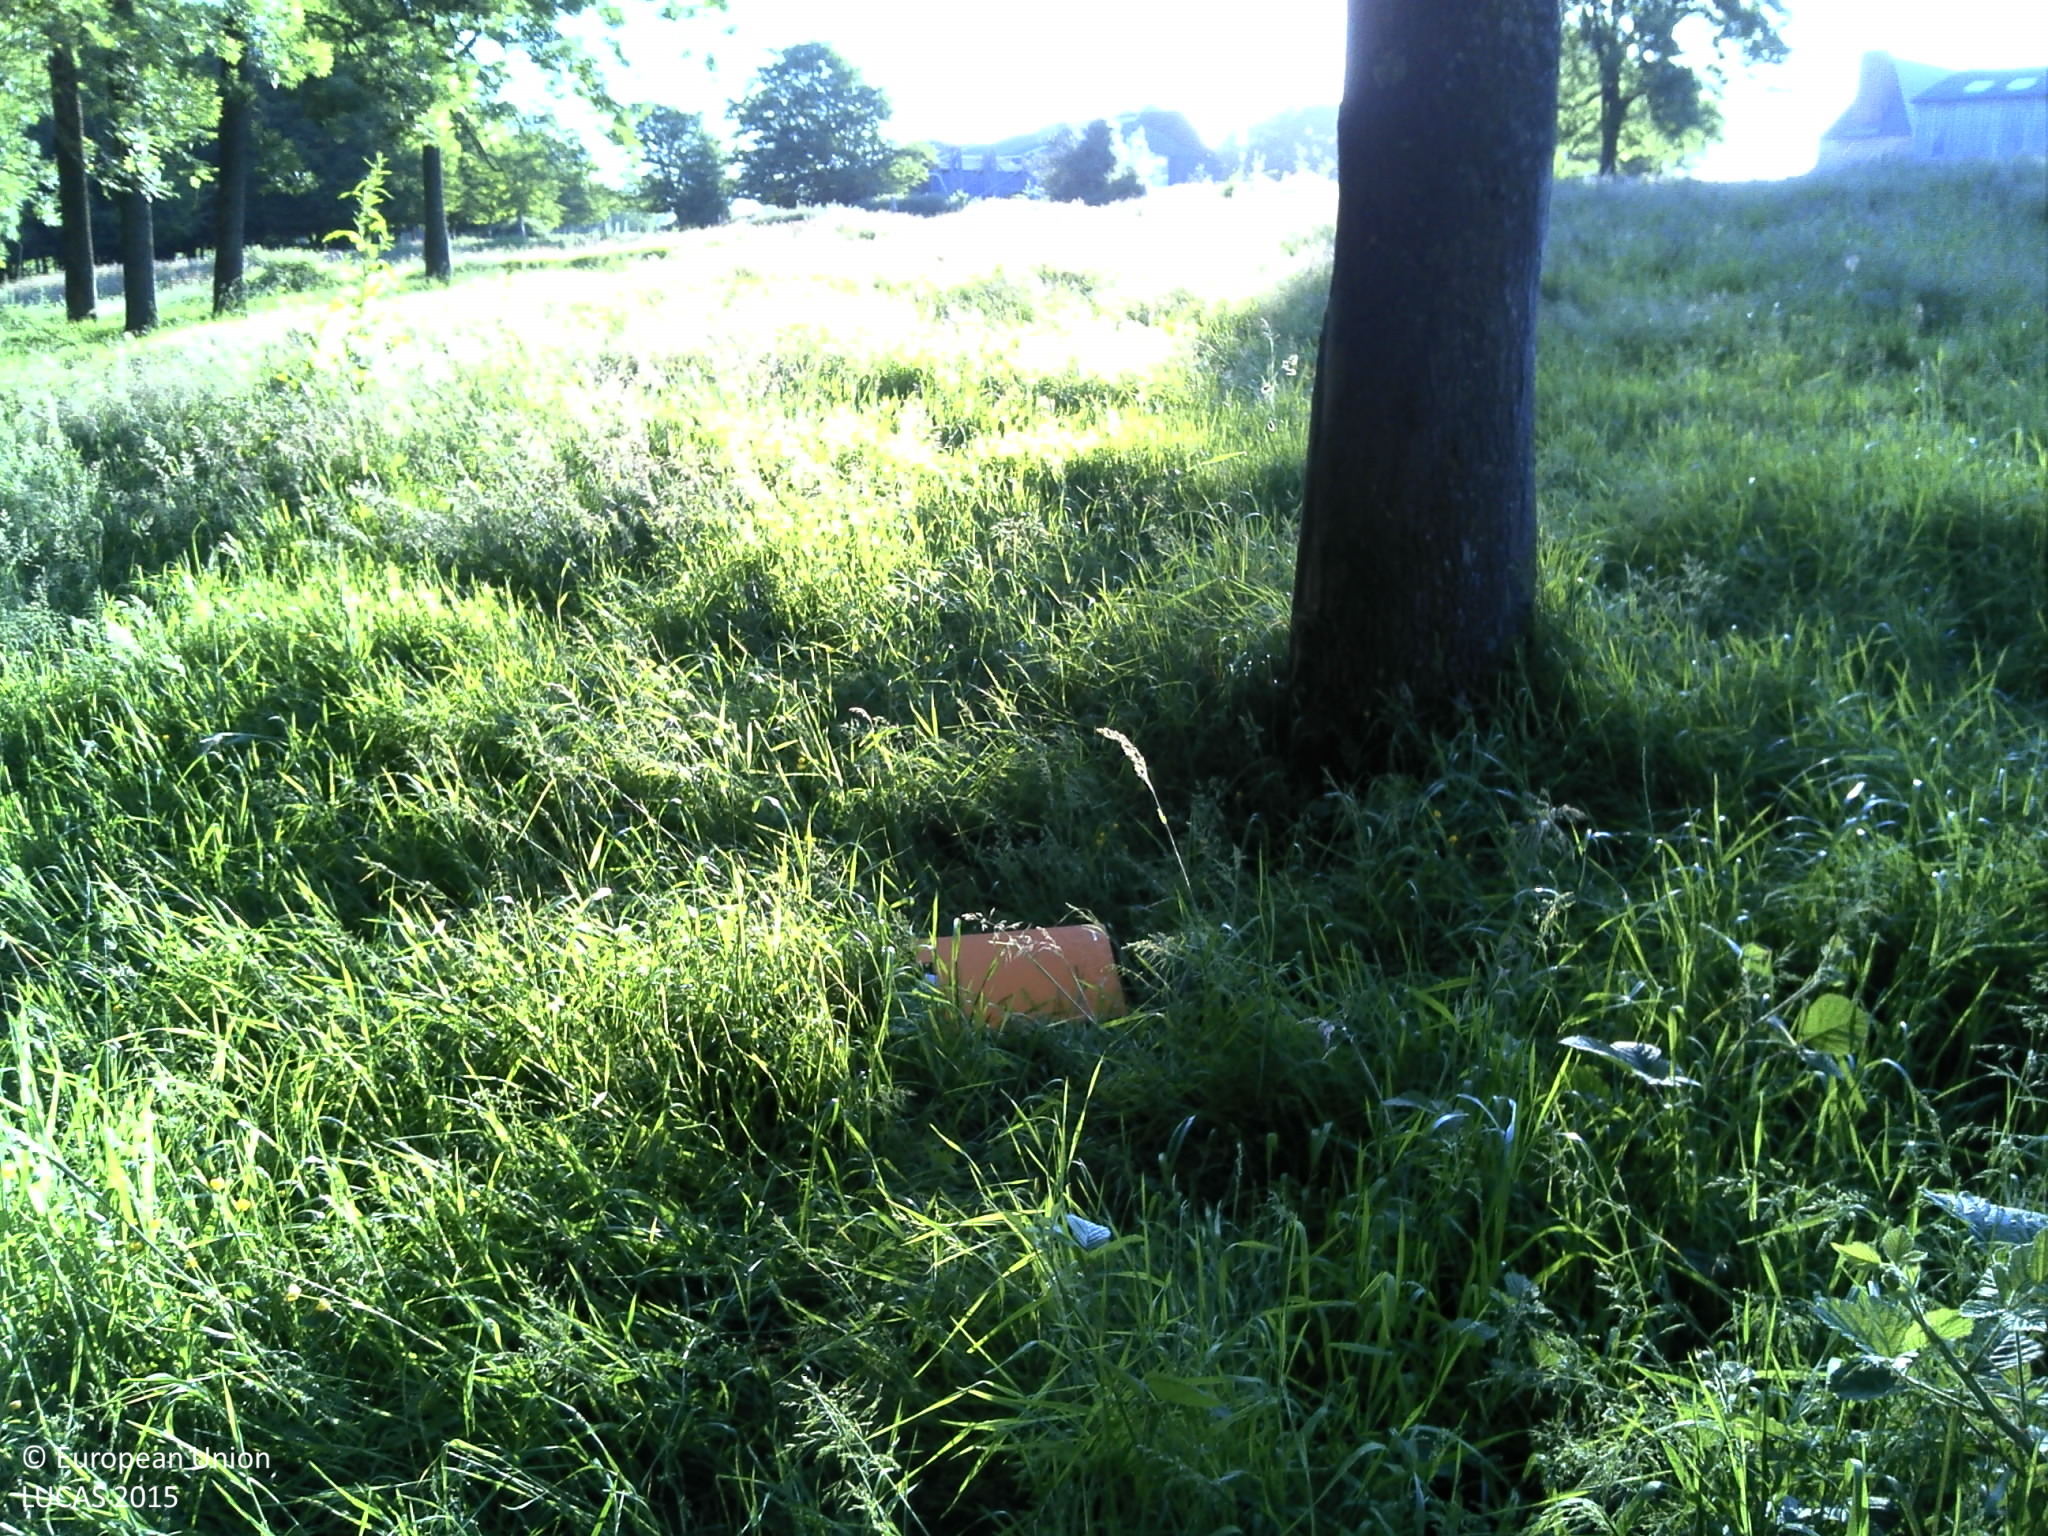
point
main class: Grassland
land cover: Grassland with sparse tree/shrub cover
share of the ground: > 75 %
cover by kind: herbaceous plants 95 %, broadleaved forest trees 5 %
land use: Agriculture (excluding fallow land and kitchen gardens)
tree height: > 5 m
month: June
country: FR
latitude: 49.5902
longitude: 0.9717
